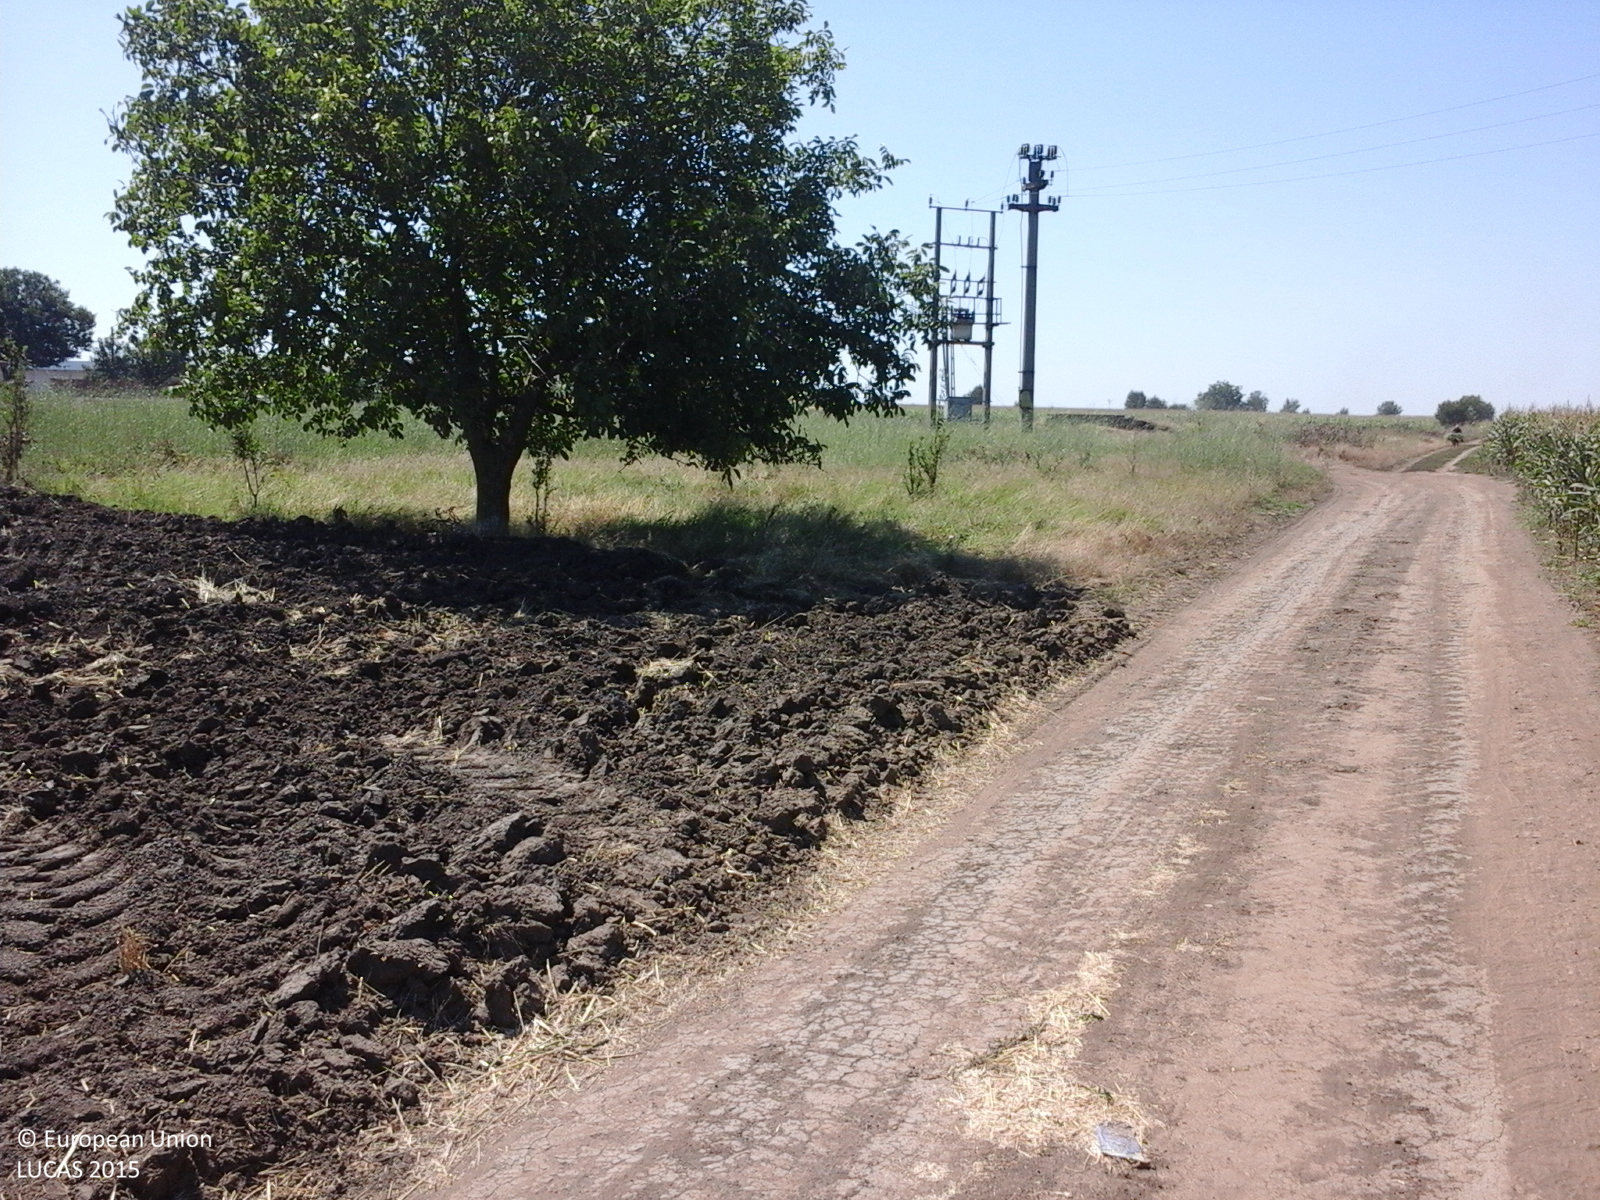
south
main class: Cropland
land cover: Maize
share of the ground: > 75 %
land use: Agriculture (excluding fallow land and kitchen gardens)
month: July
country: RO
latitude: 44.3439
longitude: 26.7147
